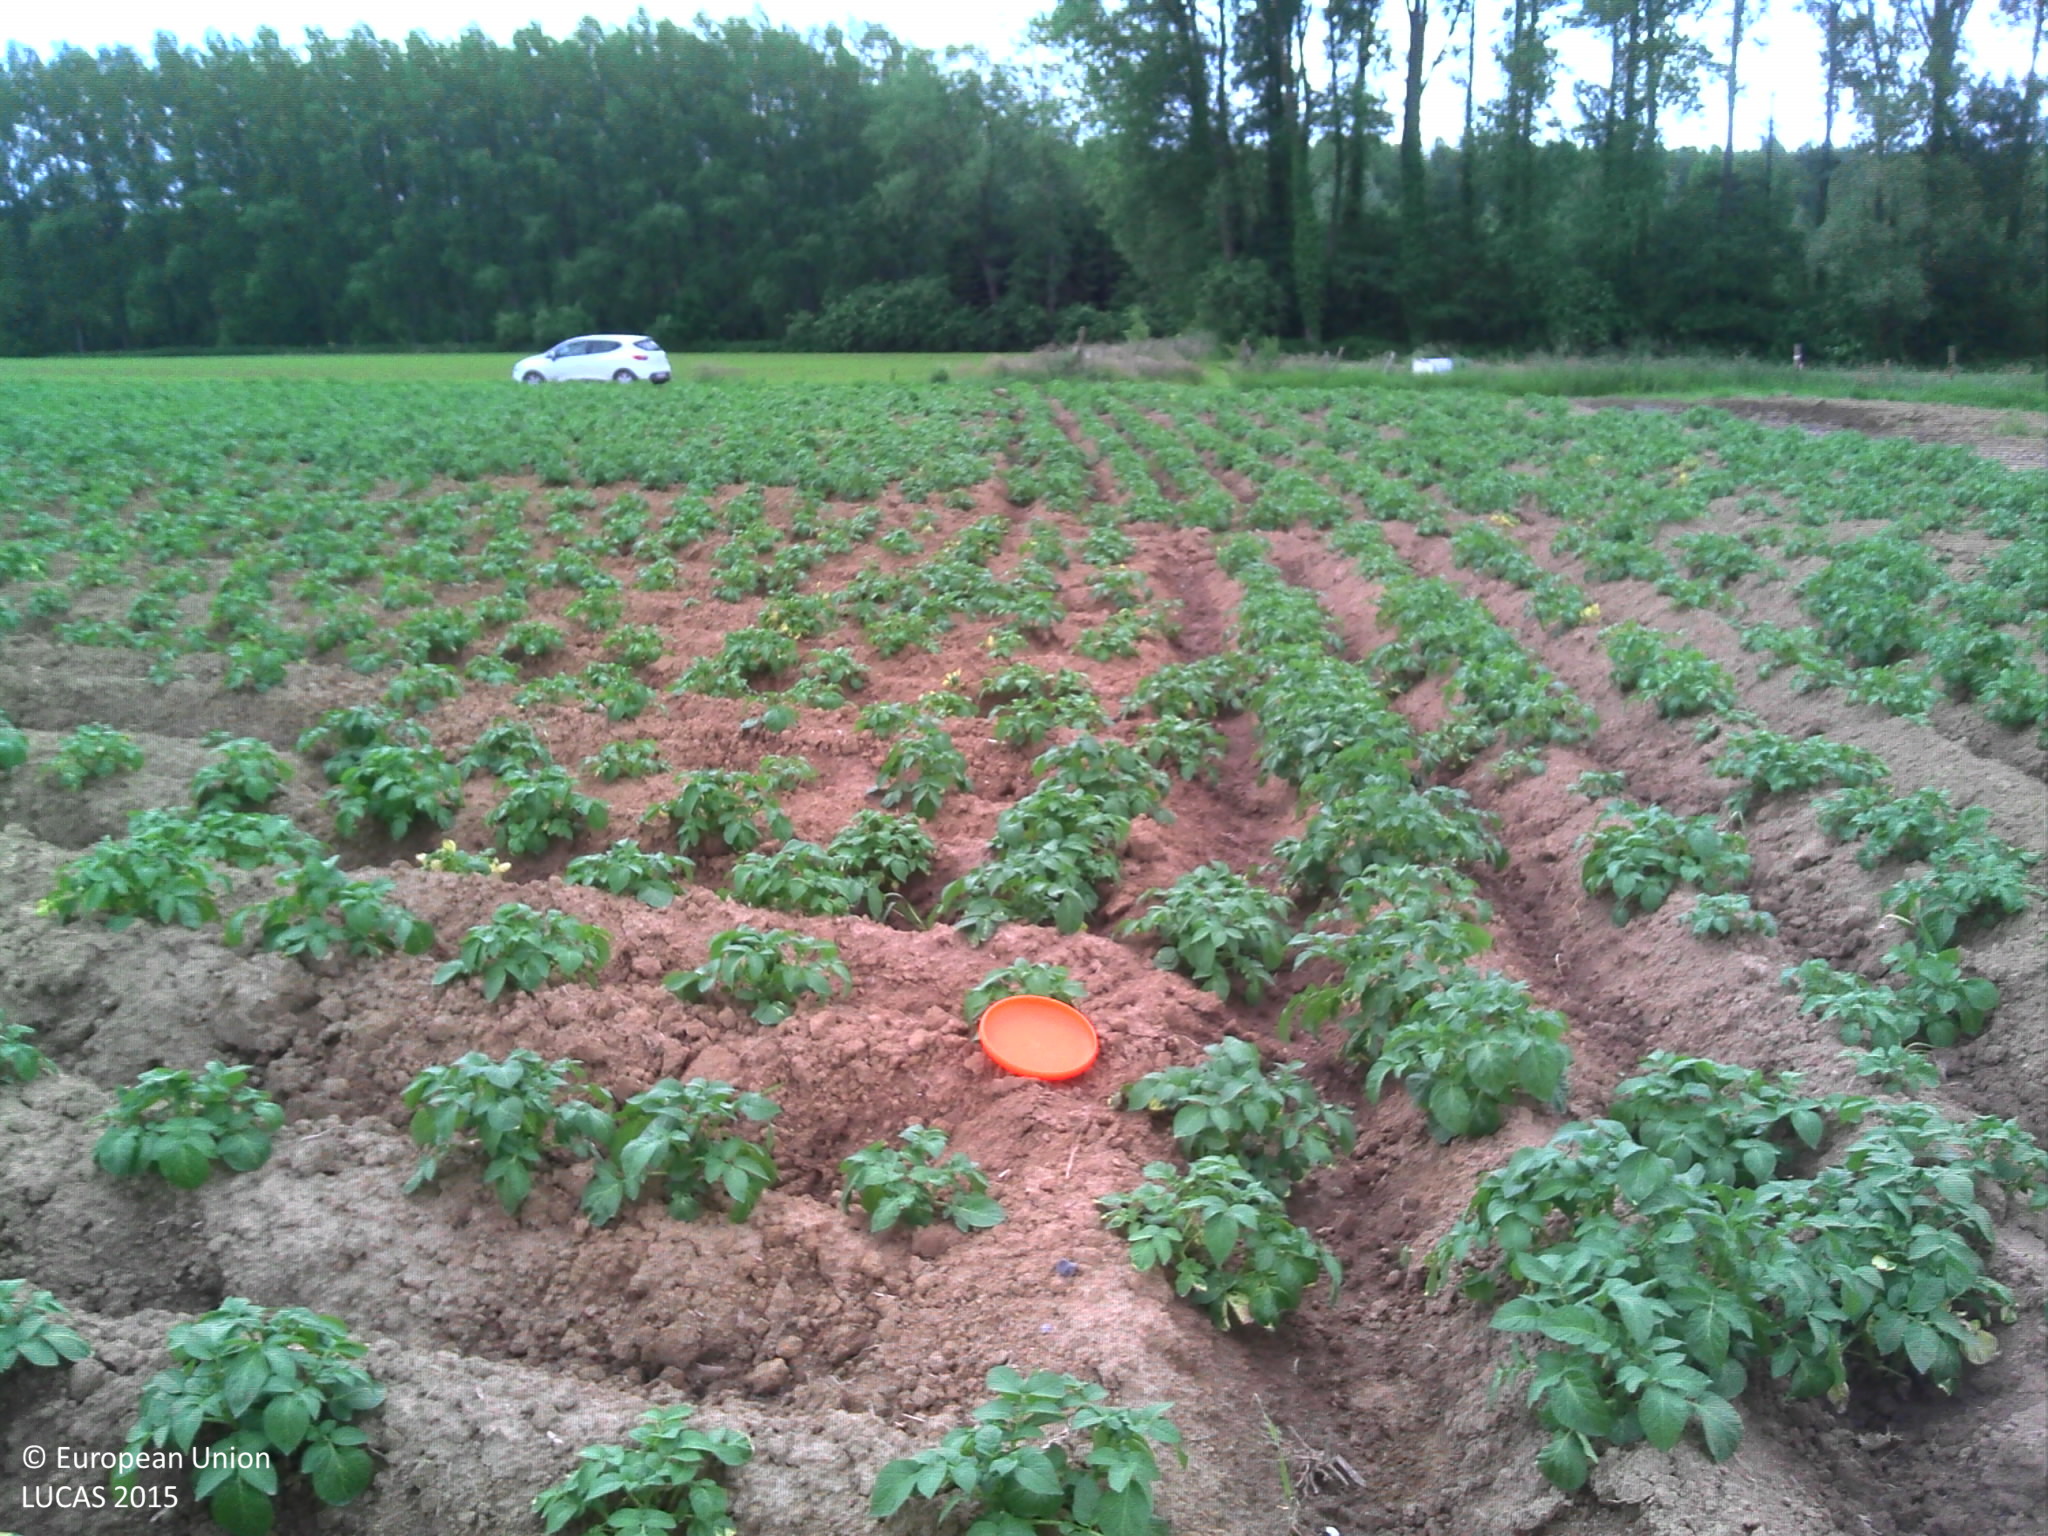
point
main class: Cropland
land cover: Potatoes
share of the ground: 50 - 75 %
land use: Agriculture (excluding fallow land and kitchen gardens)
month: June
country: BE
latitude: 50.8877
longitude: 3.9239
